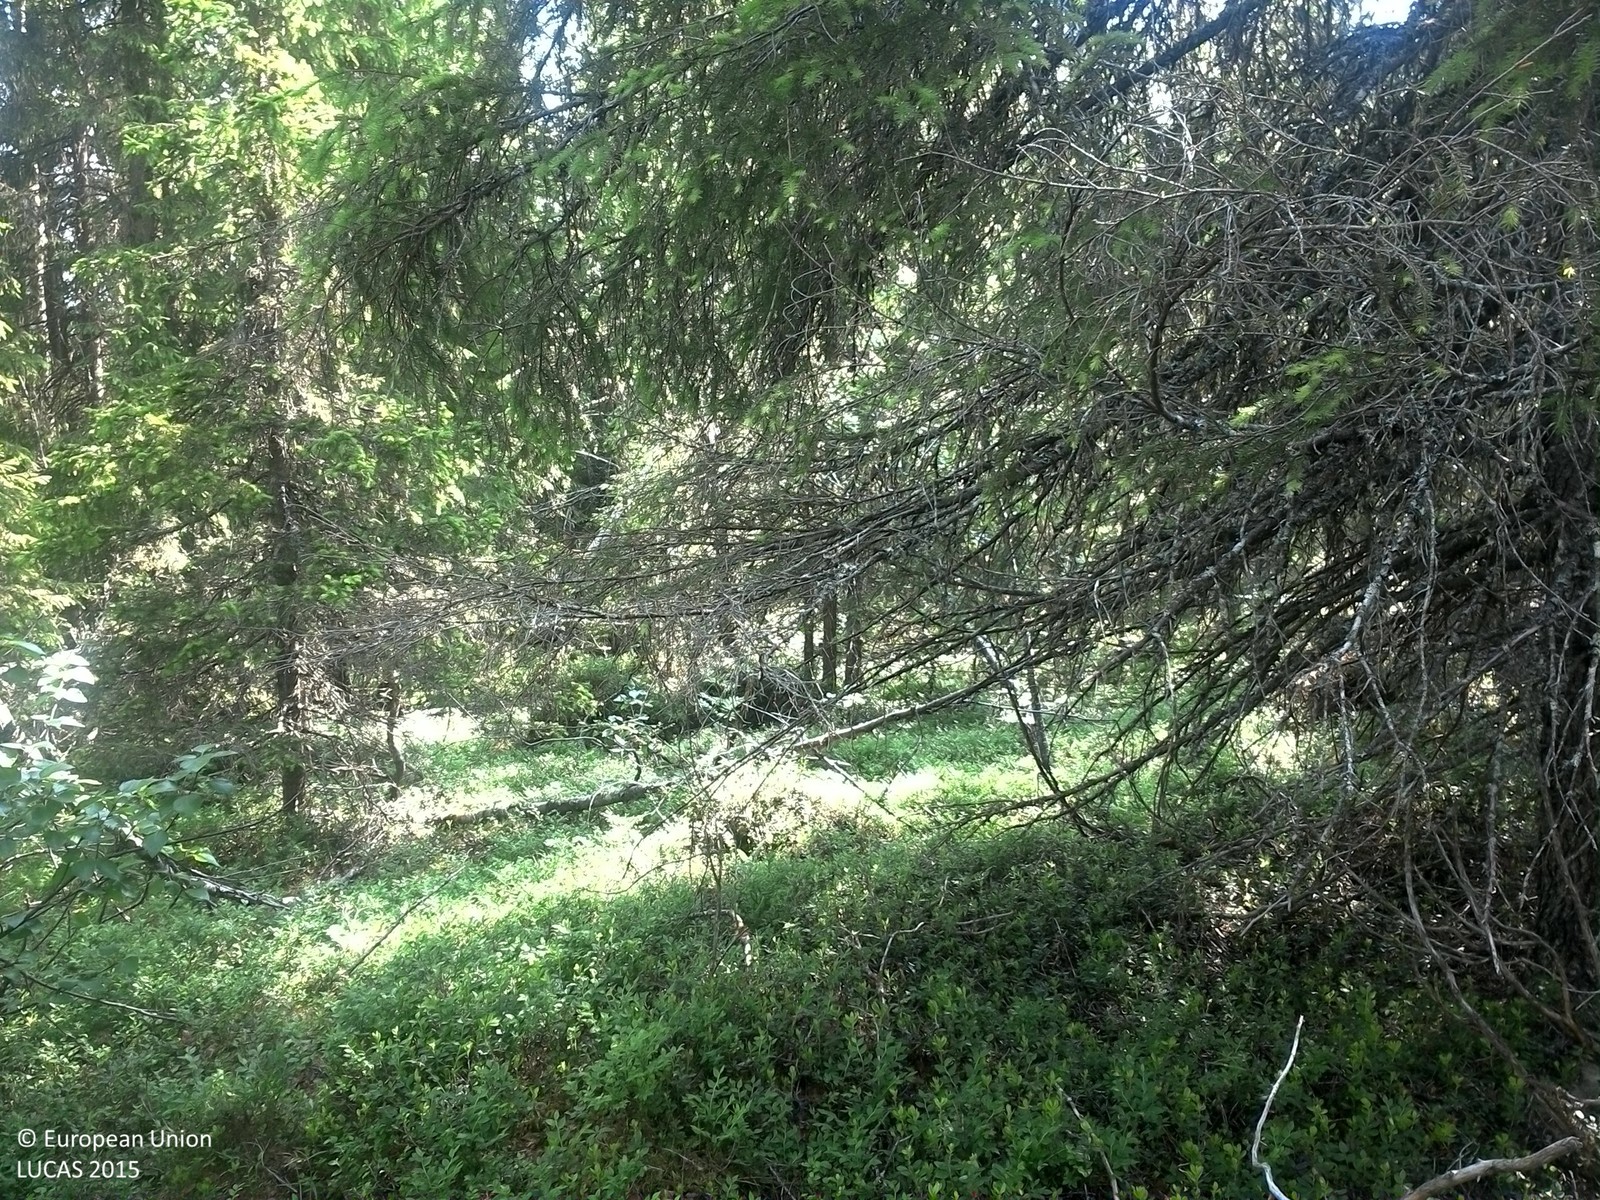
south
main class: Woodland
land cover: Spruce dominated coniferous woodland
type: boreal forest
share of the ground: 50 - 75 %
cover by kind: coniferous forest trees 55 %, shrubs 30 %, broadleaved forest trees 5 %, herbaceous plants 5 %, lichens and mosses 5 %
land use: Forestry
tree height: > 5 m
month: July
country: SE
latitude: 64.7274
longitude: 15.7831
